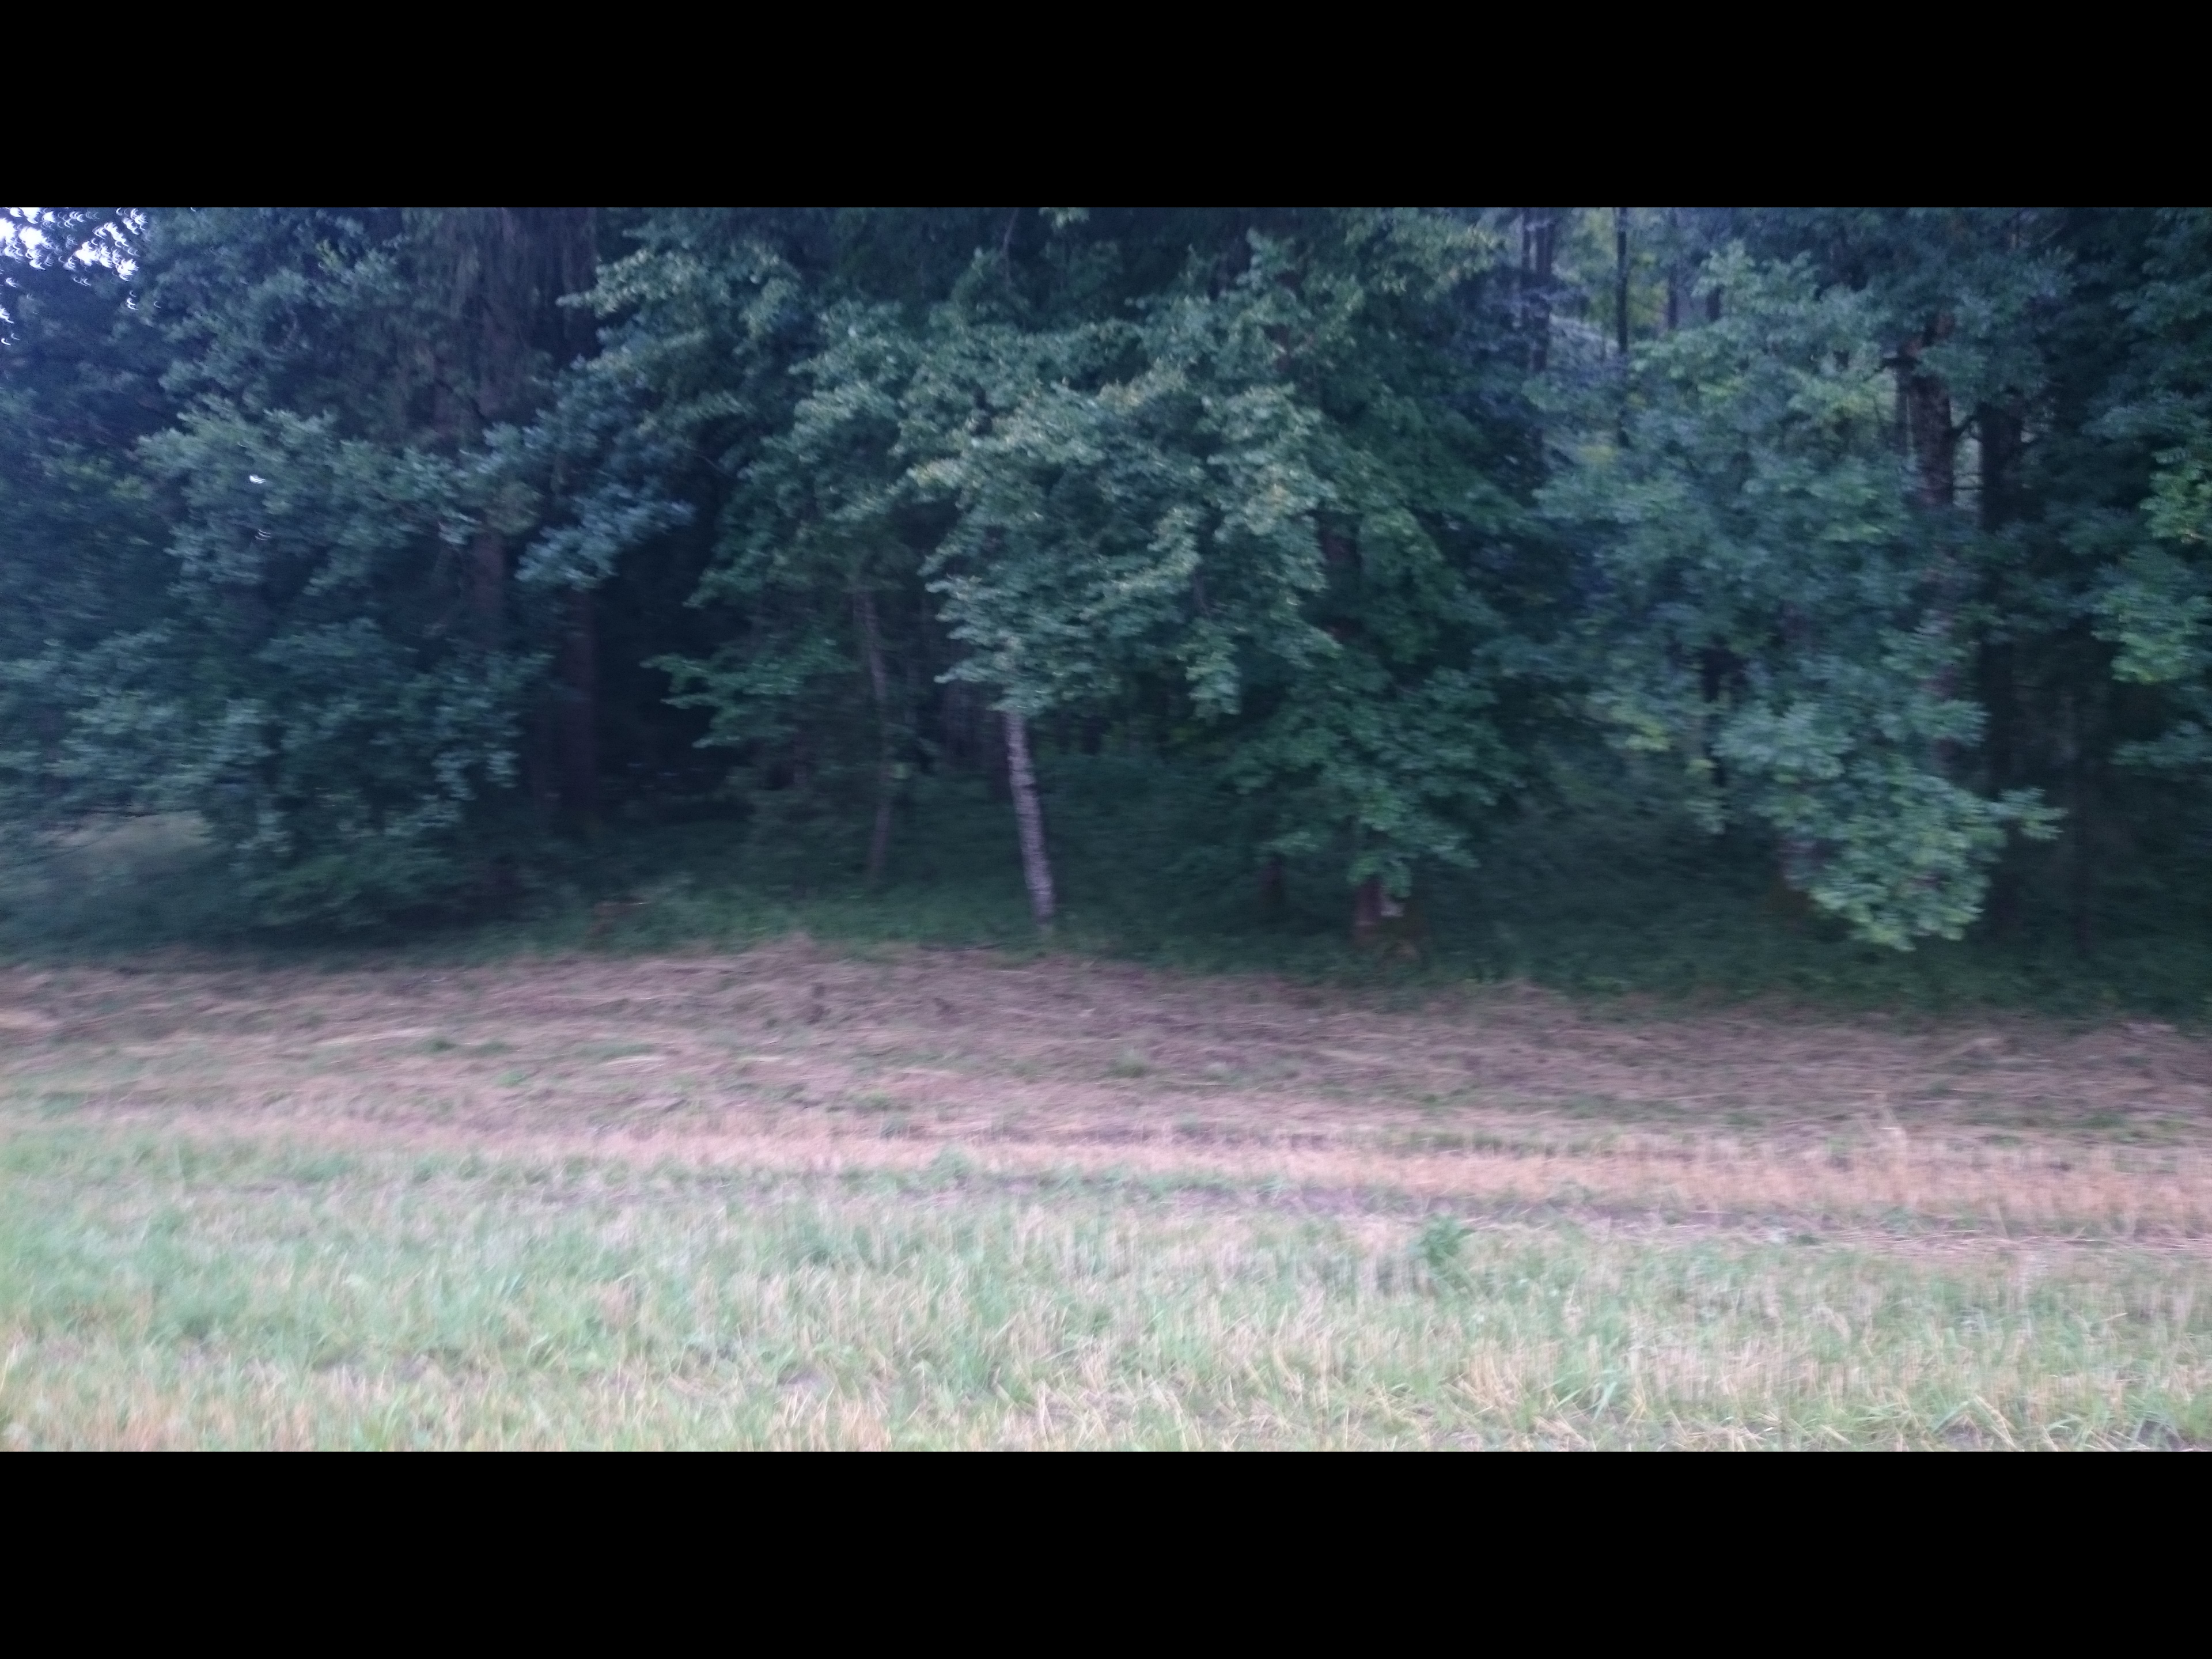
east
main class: Grassland
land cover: Spontaneously vegetated surfaces
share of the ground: > 75 %
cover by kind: herbaceous plants 100 %
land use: Agriculture (excluding fallow land and kitchen gardens)
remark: Harvested field
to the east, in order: Spontaneously vegetated surfaces; Spruce dominated mixed woodland; Grassland without tree/shrub cover; Fences; Grassland without tree/shrub cover; Apple fruit; Grassland without tree/shrub cover; Fences; Grass margins; Tracks; Grassland with sparse tree/shrub cover; Spruce dominated coniferous woodland; Spruce dominated mixed woodland; Artificial constructions in urban areas
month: July
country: AT
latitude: 47.1926
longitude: 15.6892
